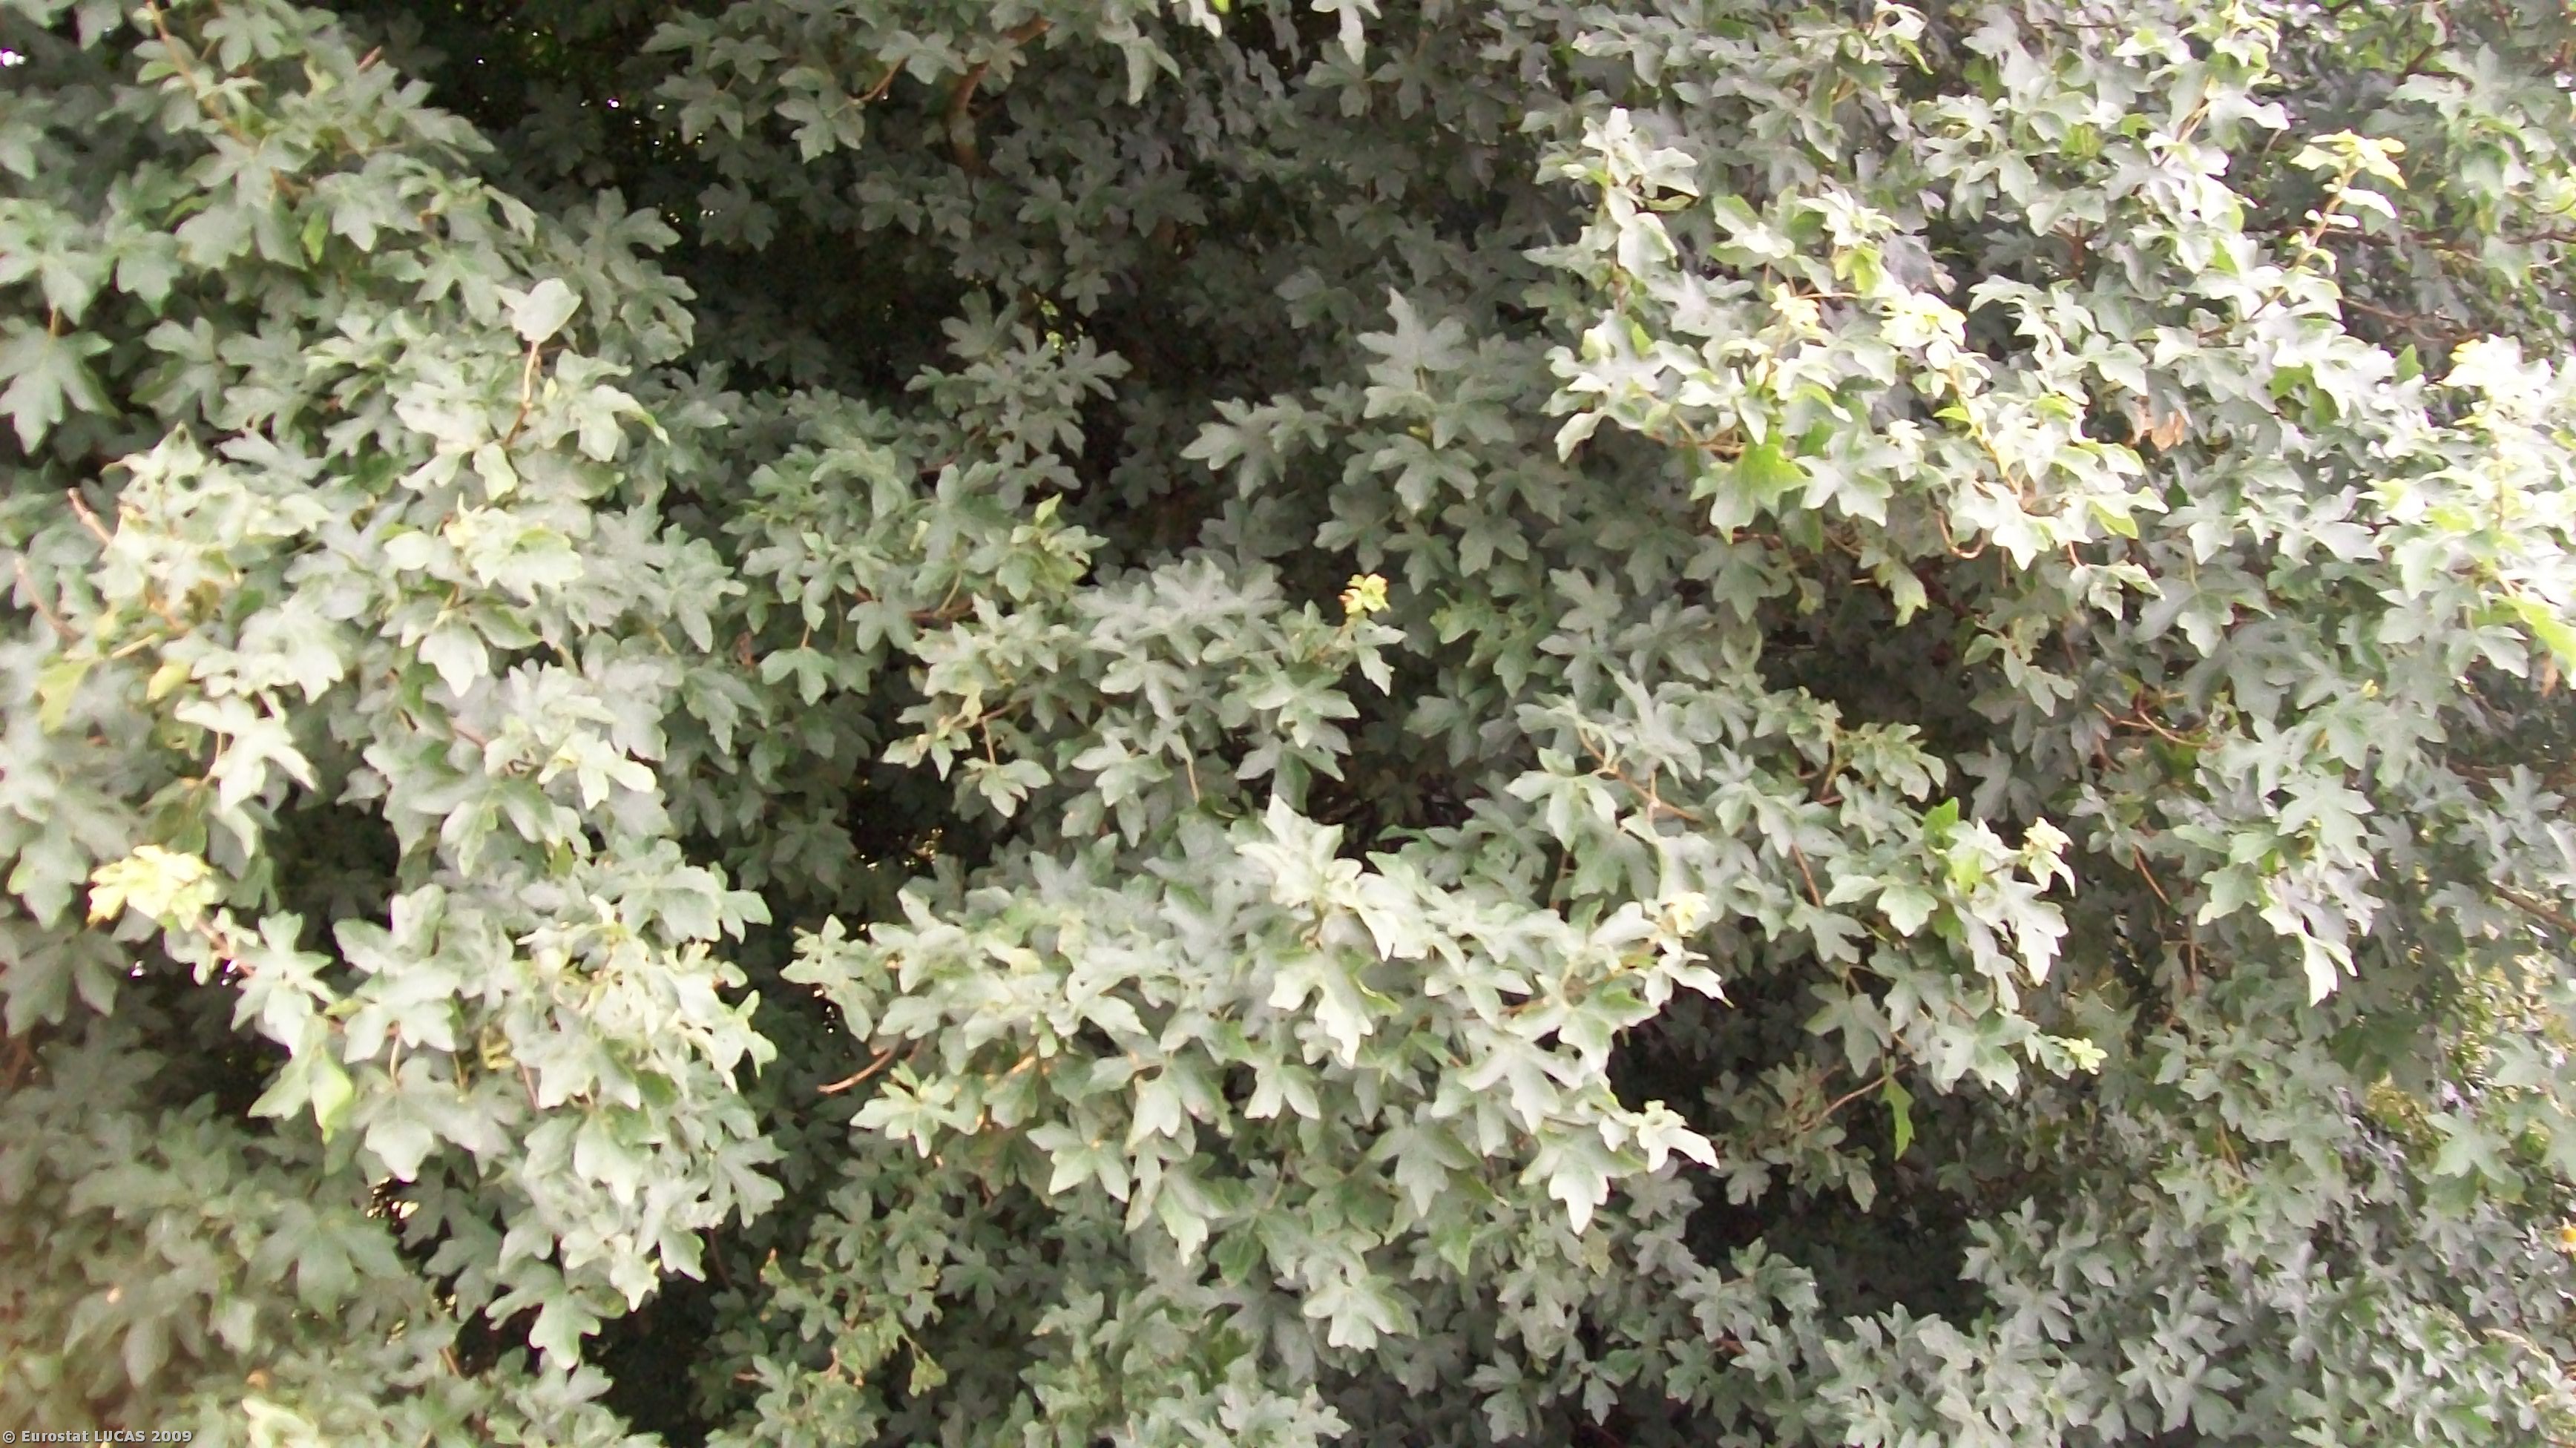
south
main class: Grassland
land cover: Grassland with sparse tree/shrub cover
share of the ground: > 75 %
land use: Unused
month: July
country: GB
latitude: 52.7038
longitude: -1.3405
